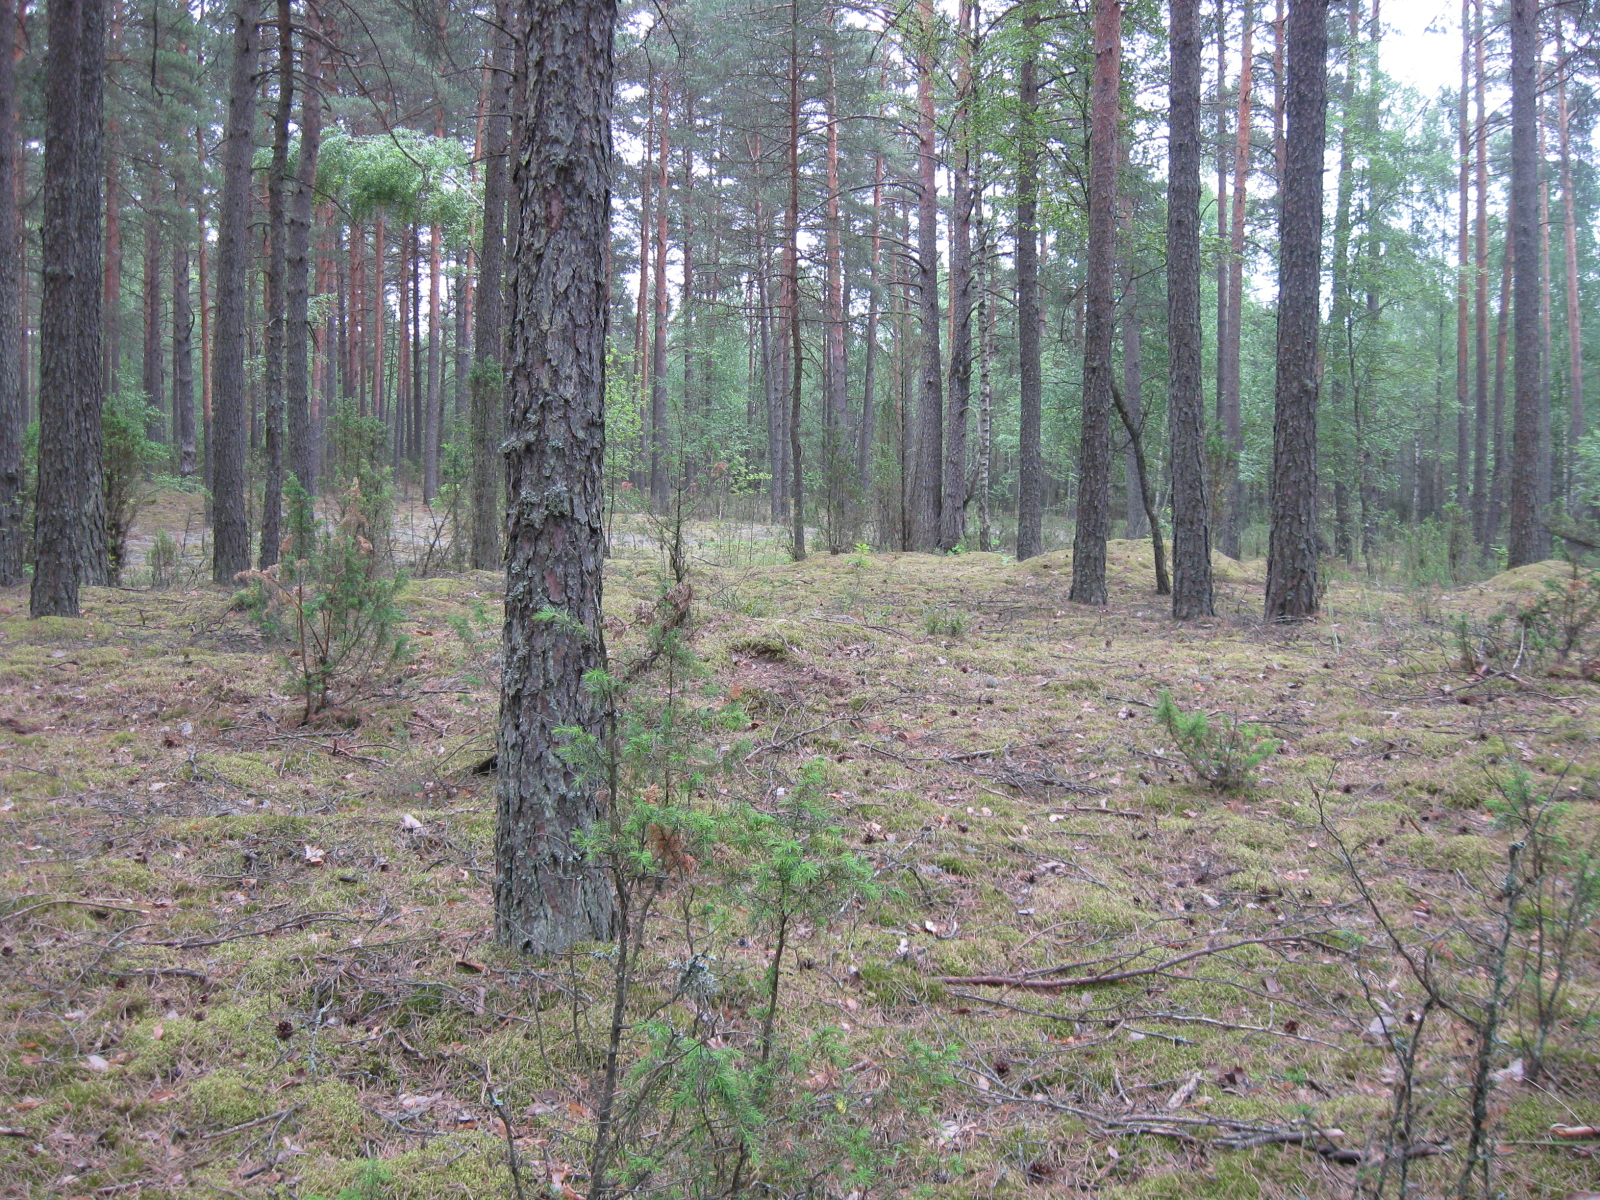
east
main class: Woodland
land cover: Pine dominated coniferous woodland
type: hemiboreal forest and nemoral coniferous forest and mixed broadleaved-coniferous forest
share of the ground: > 75 %
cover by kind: coniferous forest trees 95 %, lichens and mosses 5 %
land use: Forestry
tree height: > 5 m
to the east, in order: Pine dominated coniferous woodland; Tracks; Pine dominated mixed woodland; Tracks; Pine dominated mixed woodland
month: July
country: LT
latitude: 54.1388
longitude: 24.2883
